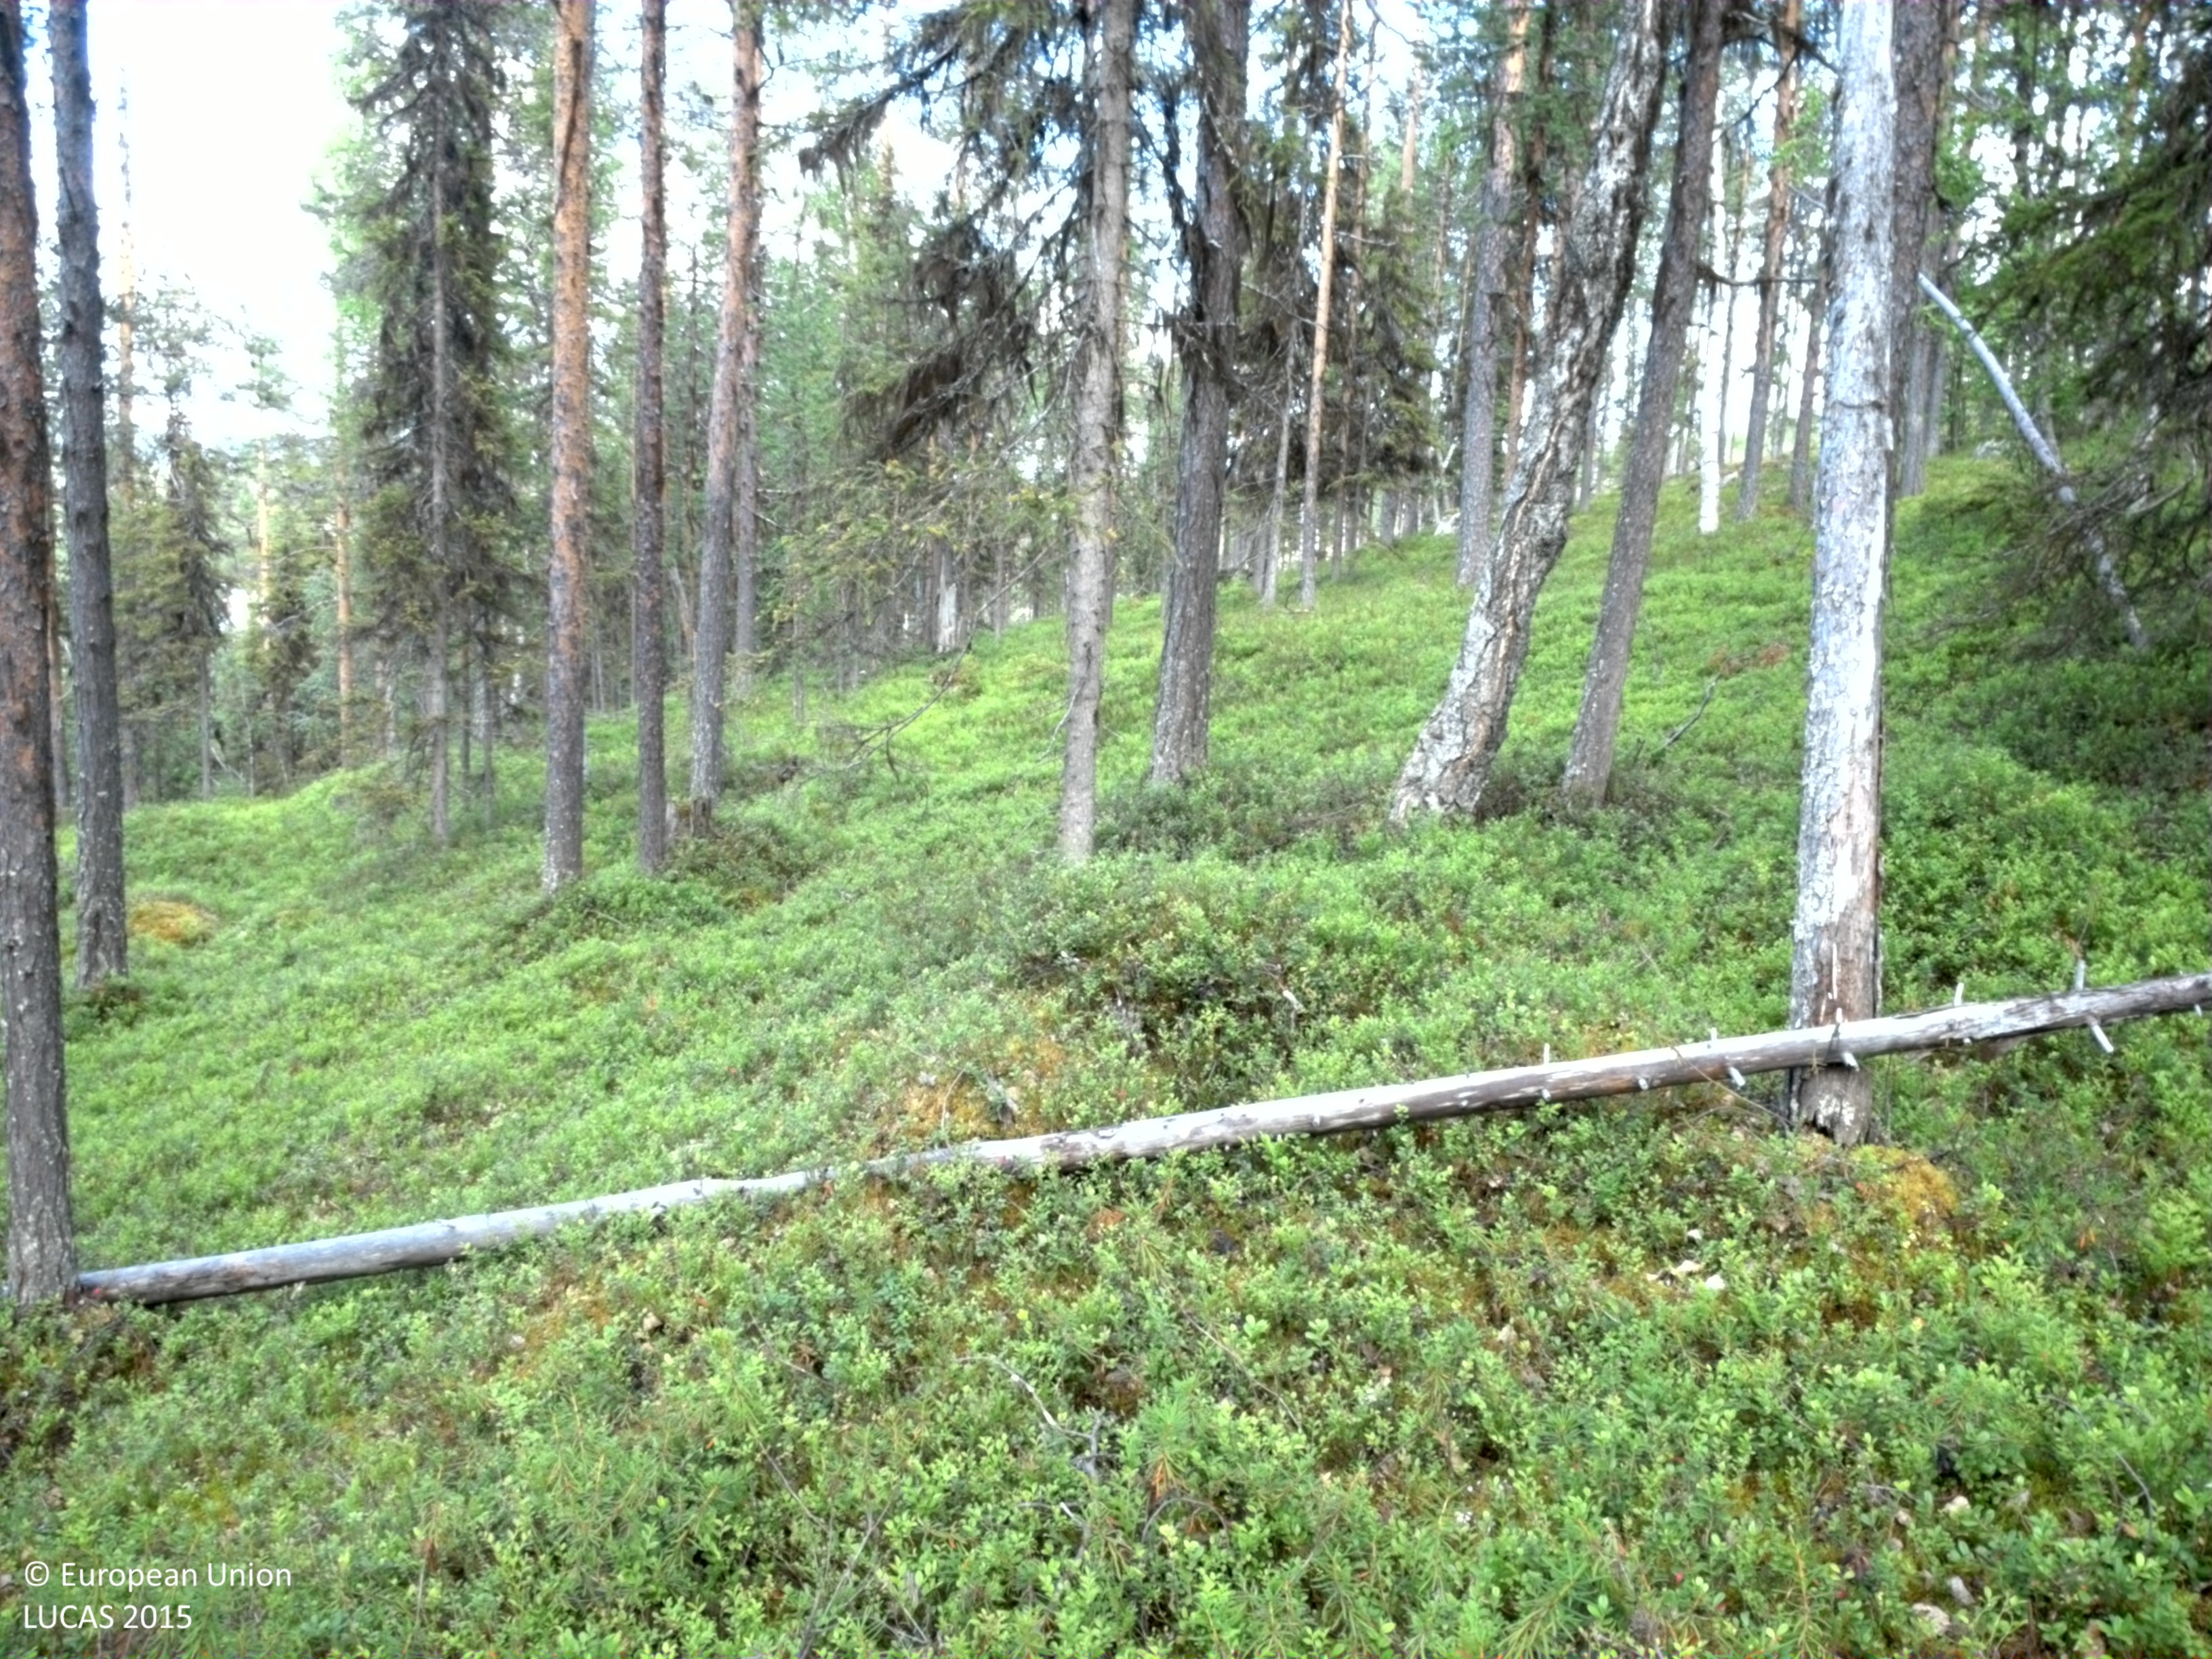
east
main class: Woodland
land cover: Pine dominated coniferous woodland
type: boreal forest
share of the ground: 25 - 50 %
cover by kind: shrubs 65 %, coniferous forest trees 30 %, broadleaved forest trees 5 %
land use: Forestry
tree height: > 5 m
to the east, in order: Pine dominated coniferous woodland; Shrubland with sparse tree cover; Pine dominated coniferous woodland; Spruce dominated mixed woodland
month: August
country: SE
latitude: 66.5626
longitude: 20.0246
